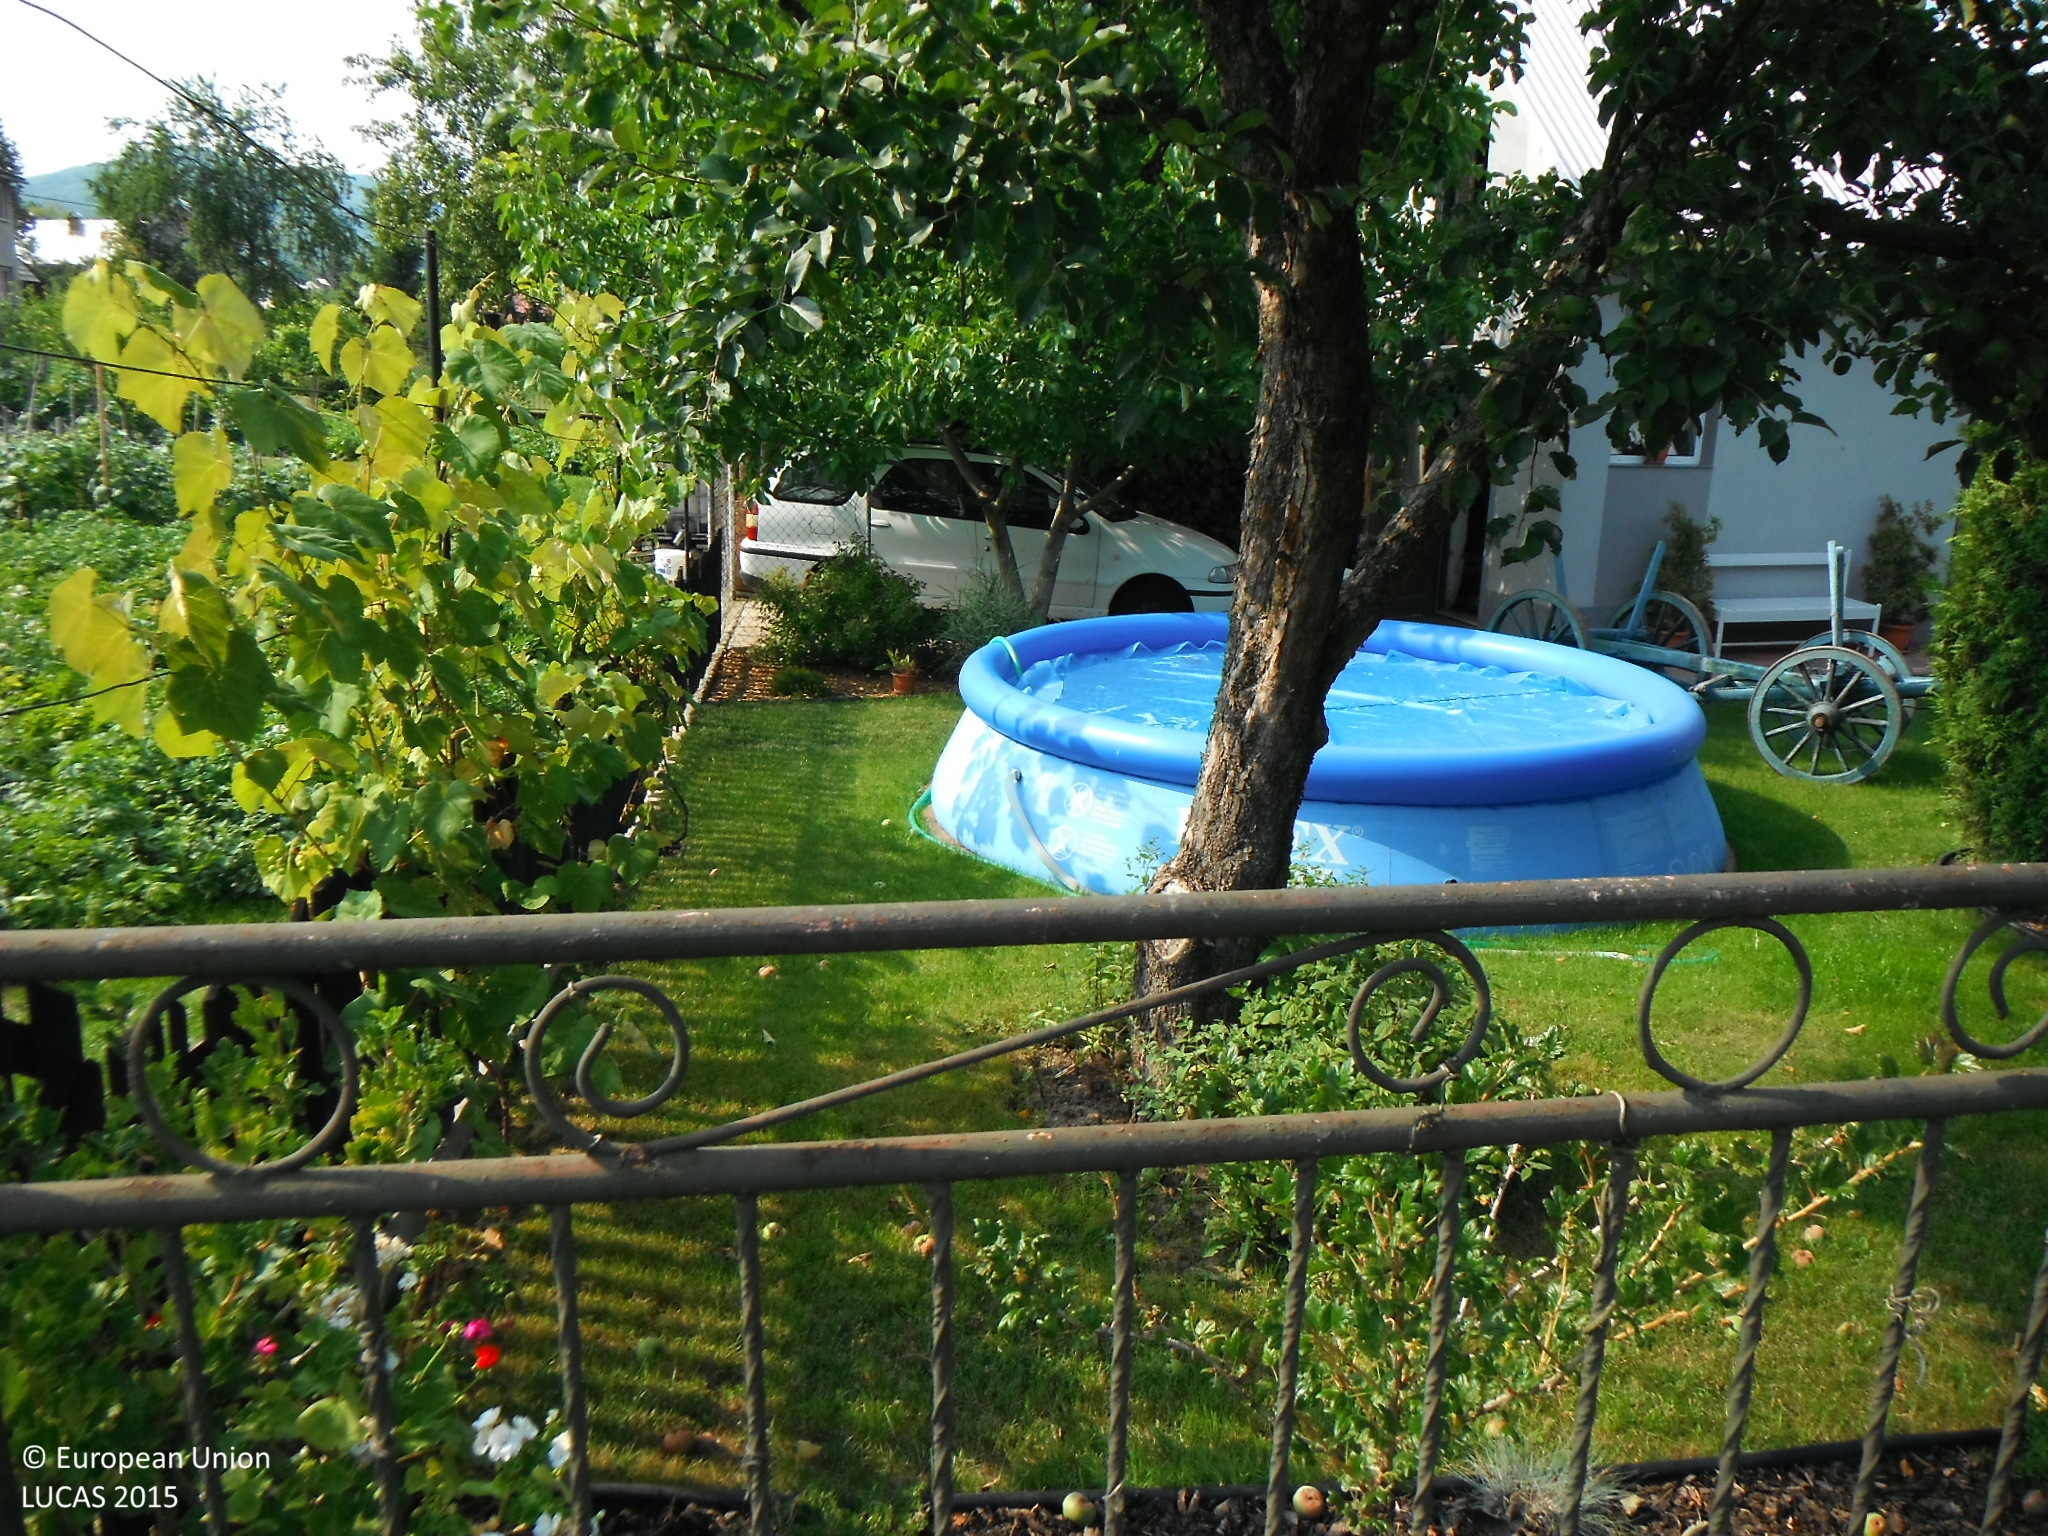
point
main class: Cropland
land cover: Apple fruit
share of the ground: 25 - 50 %
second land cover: Grassland without tree/shrub cover
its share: 50 - 75 %
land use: Kitchen garden
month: July
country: SK
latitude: 49.2994
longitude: 21.4206
